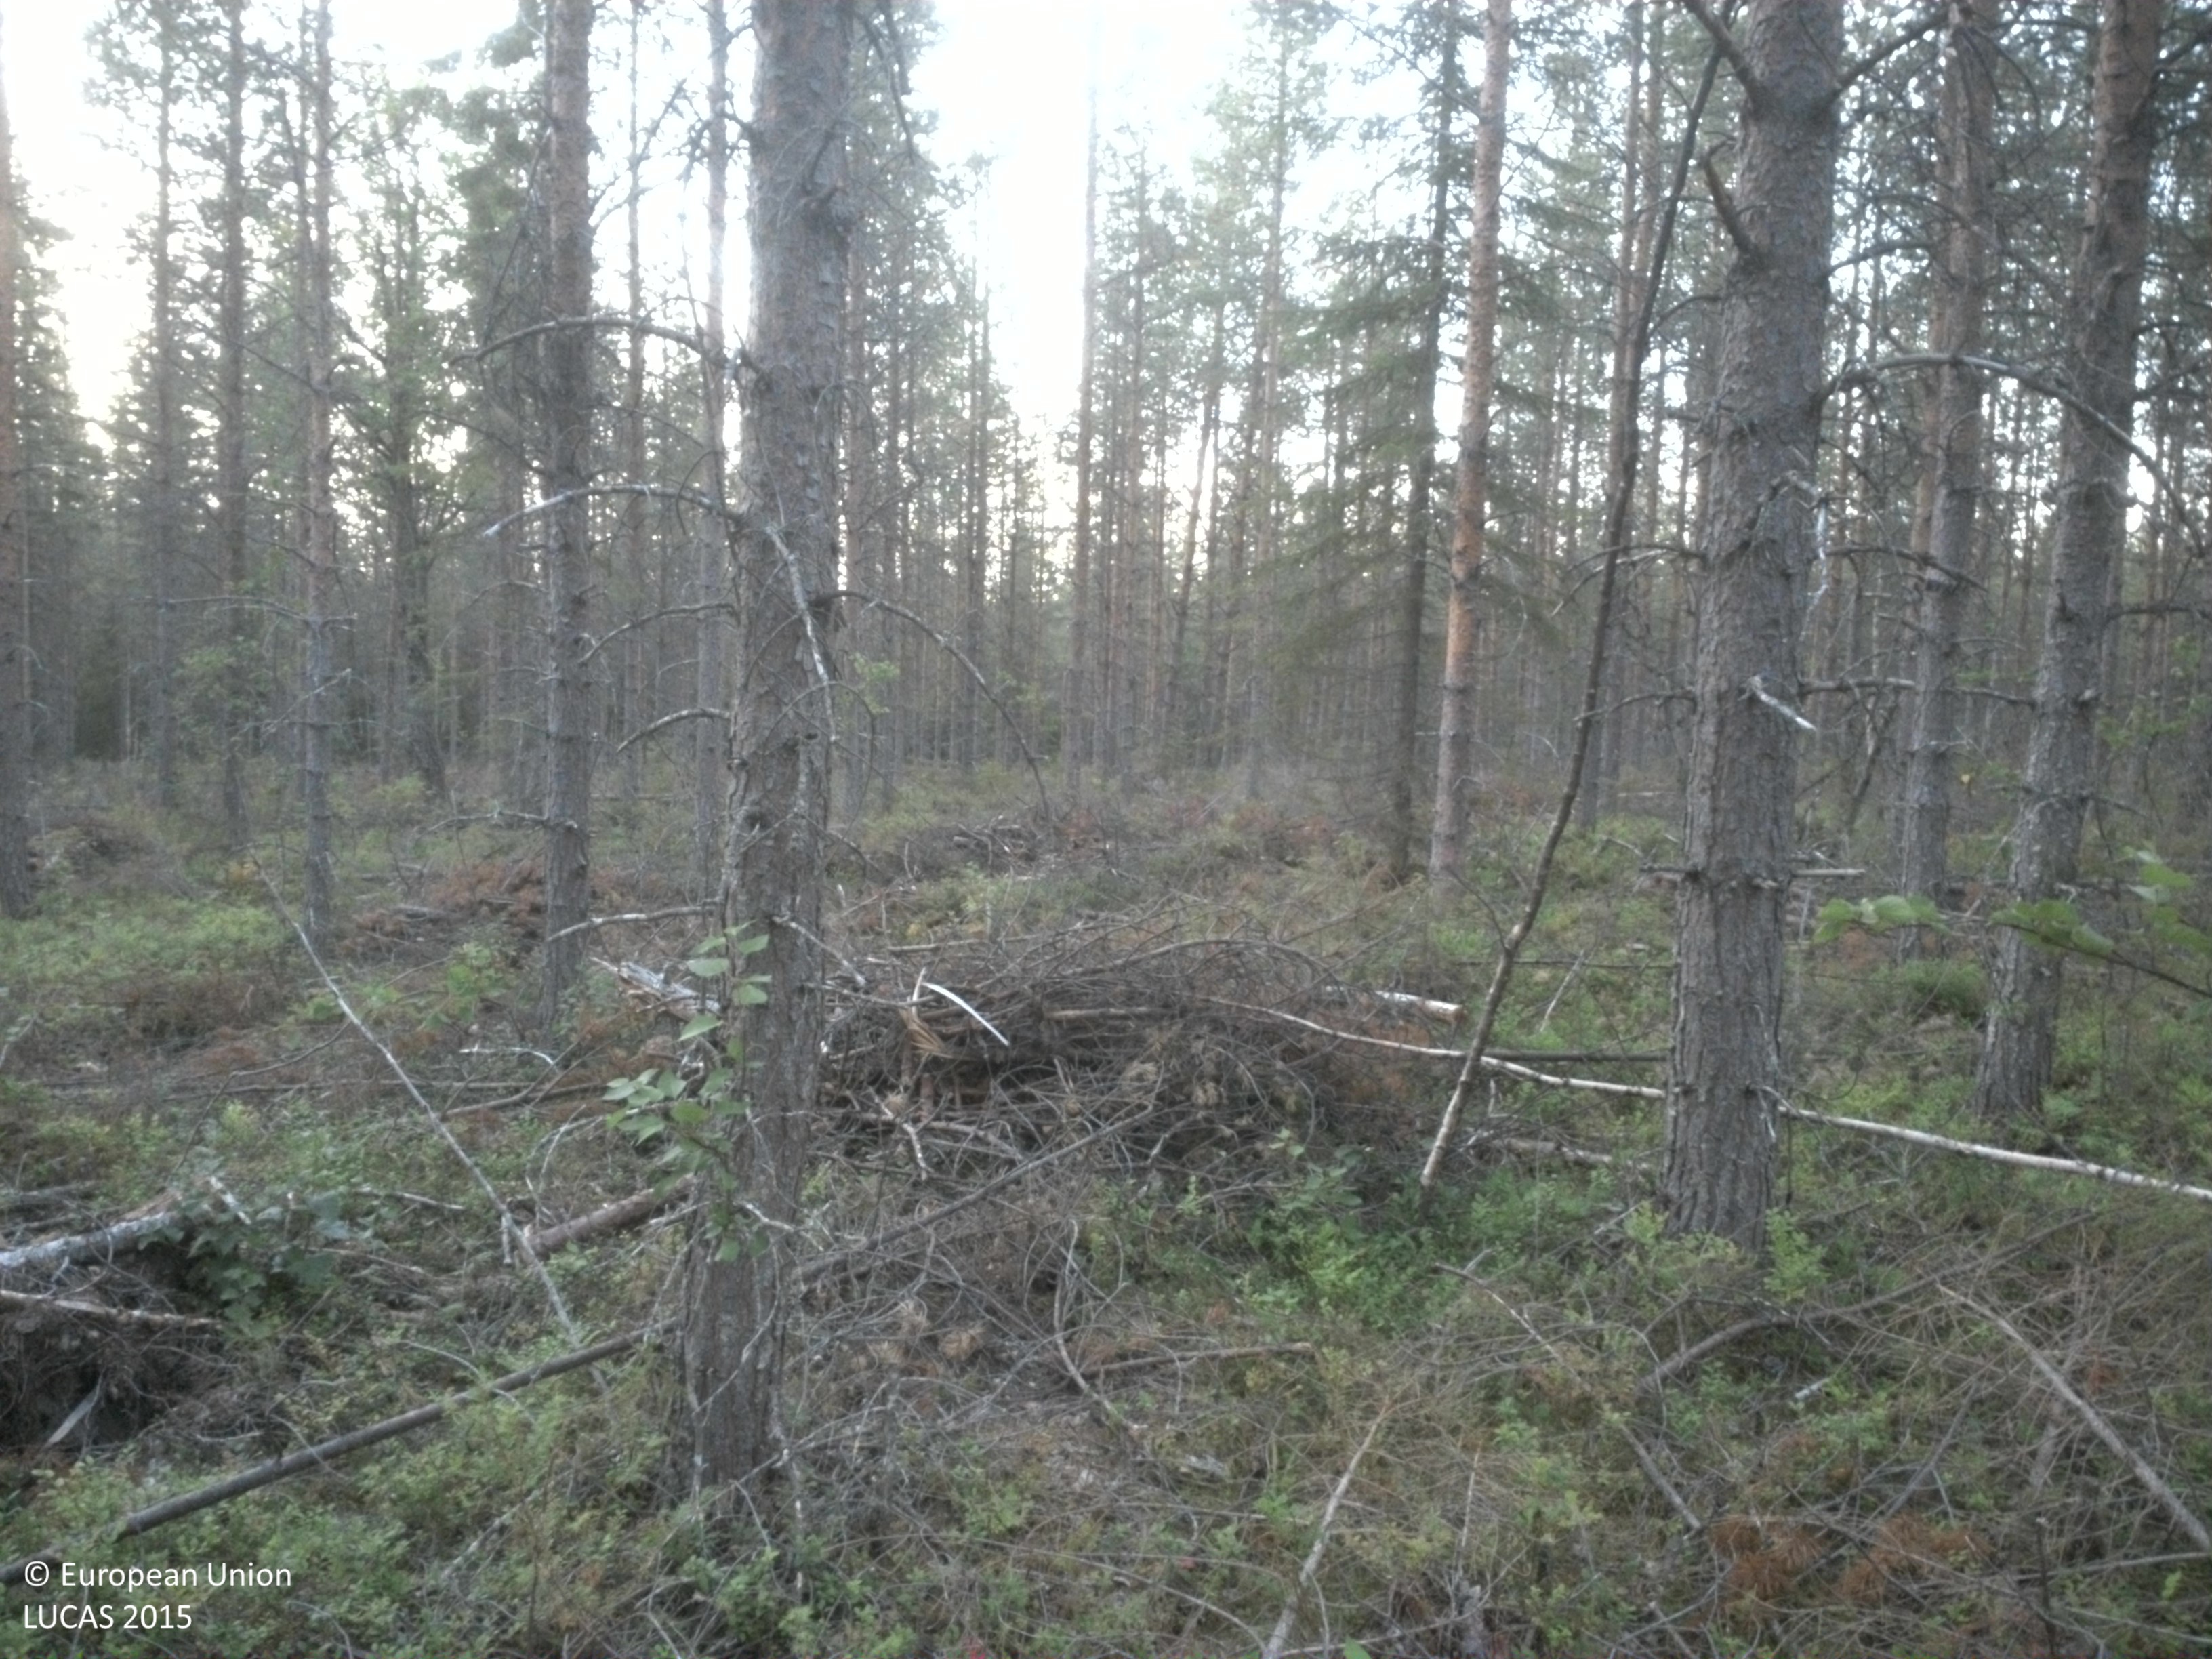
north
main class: Woodland
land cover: Pine dominated coniferous woodland
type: boreal forest
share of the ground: 50 - 75 %
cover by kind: coniferous forest trees 60 %, shrubs 30 %, herbaceous plants 5 %, lichens and mosses 5 %
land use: Forestry
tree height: > 5 m
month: August
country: SE
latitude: 64.6078
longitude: 18.4741
